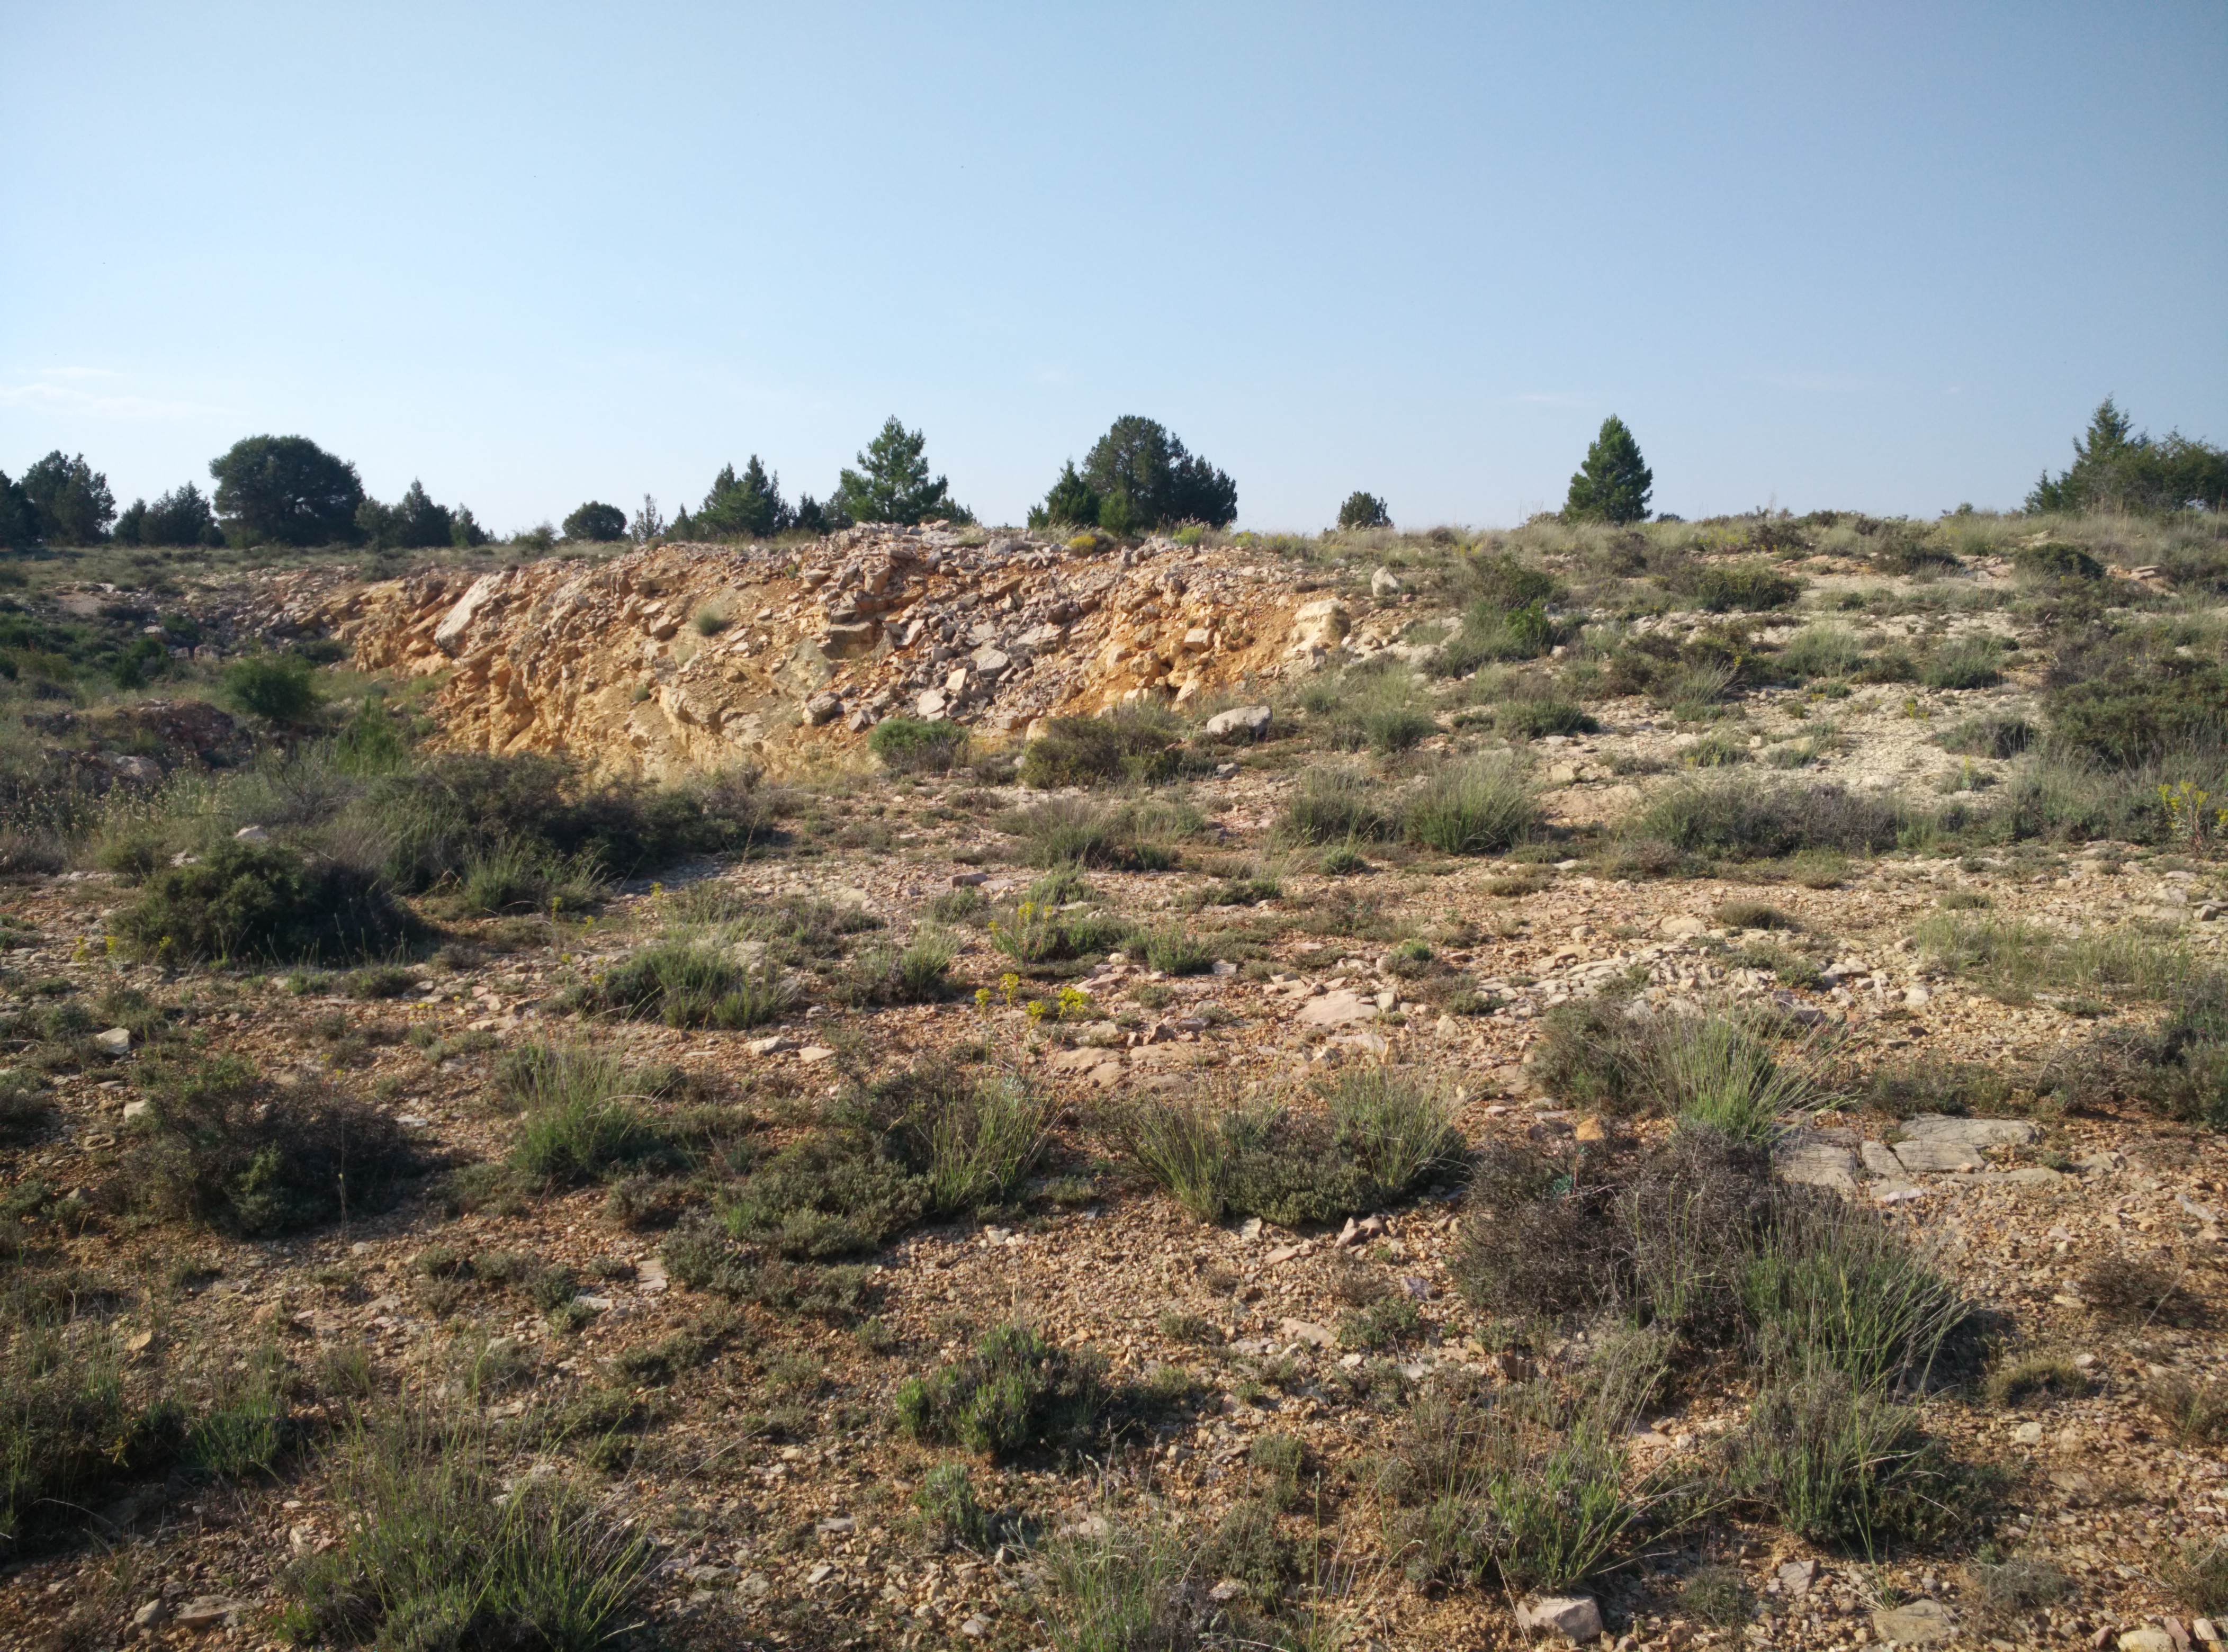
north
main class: Shrubland
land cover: Shrubland with sparse tree cover
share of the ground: 25 - 50 %
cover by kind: unconsolidated bare surface 50 %, shrubs 40 %, coniferous forest trees 5 %, herbaceous plants 5 %
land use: Semi-natural and natural areas not in use
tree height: > 5 m
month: June
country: ES
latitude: 40.7757
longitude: -1.9534
